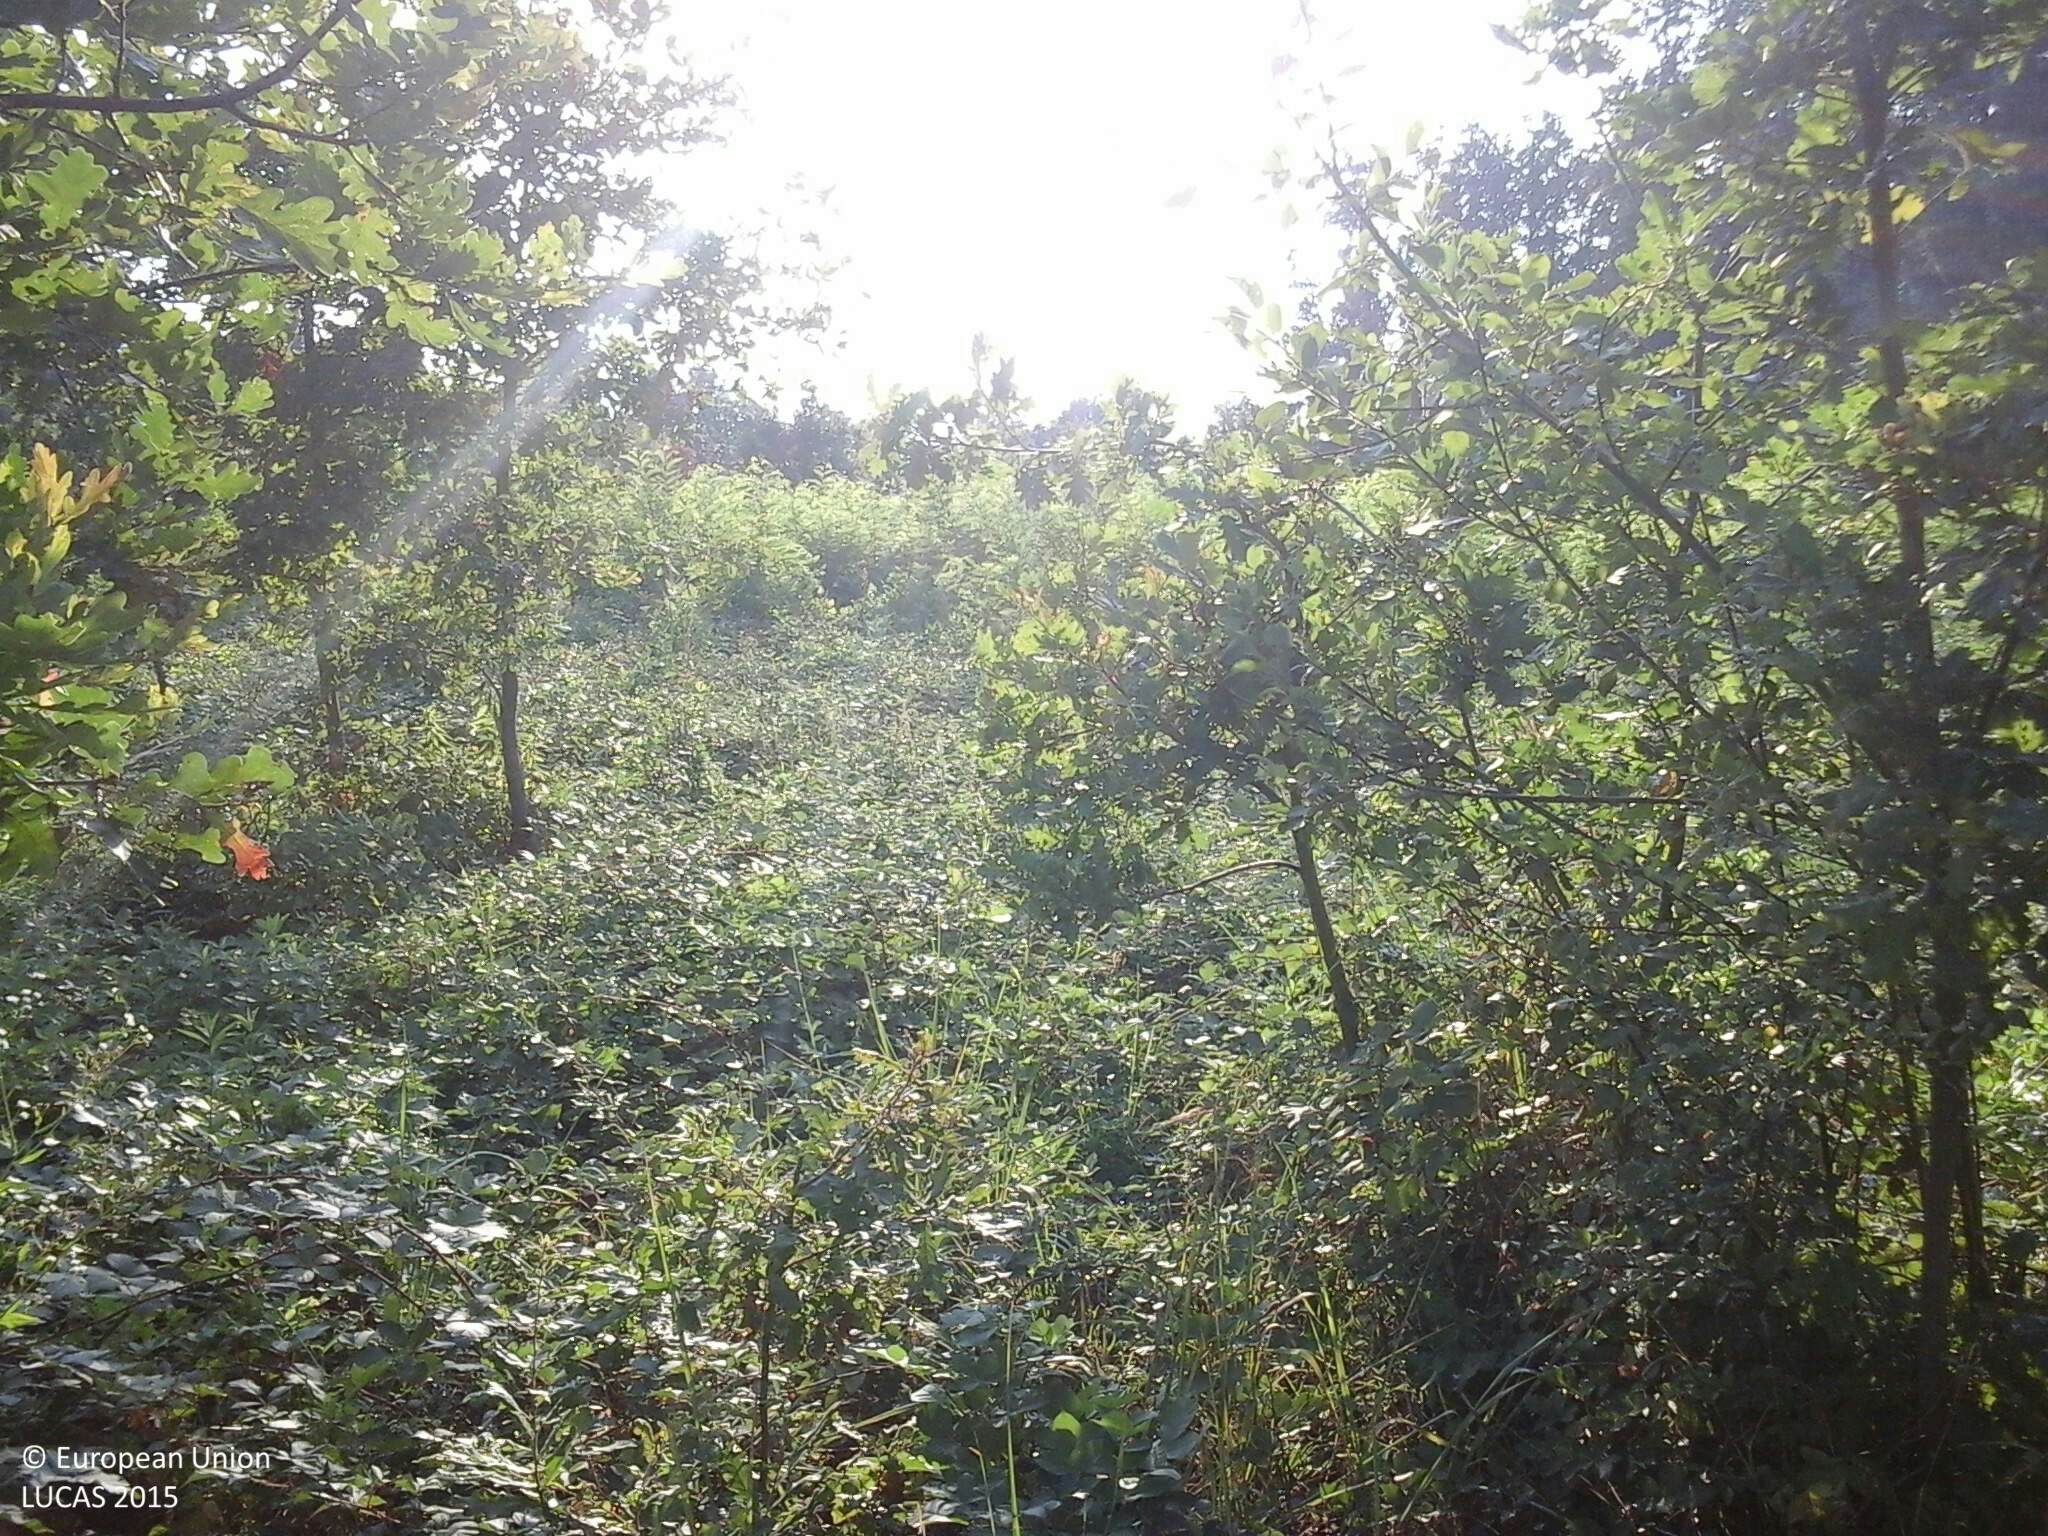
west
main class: Woodland
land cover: Broadleaved woodland
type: acidophilous oak and oak-birch forest
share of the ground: 25 - 50 %
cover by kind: shrubs 60 %, broadleaved forest trees 40 %
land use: Forestry
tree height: < 5 m
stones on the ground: < 10 %
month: August
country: HU
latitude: 45.9555
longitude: 18.0696
